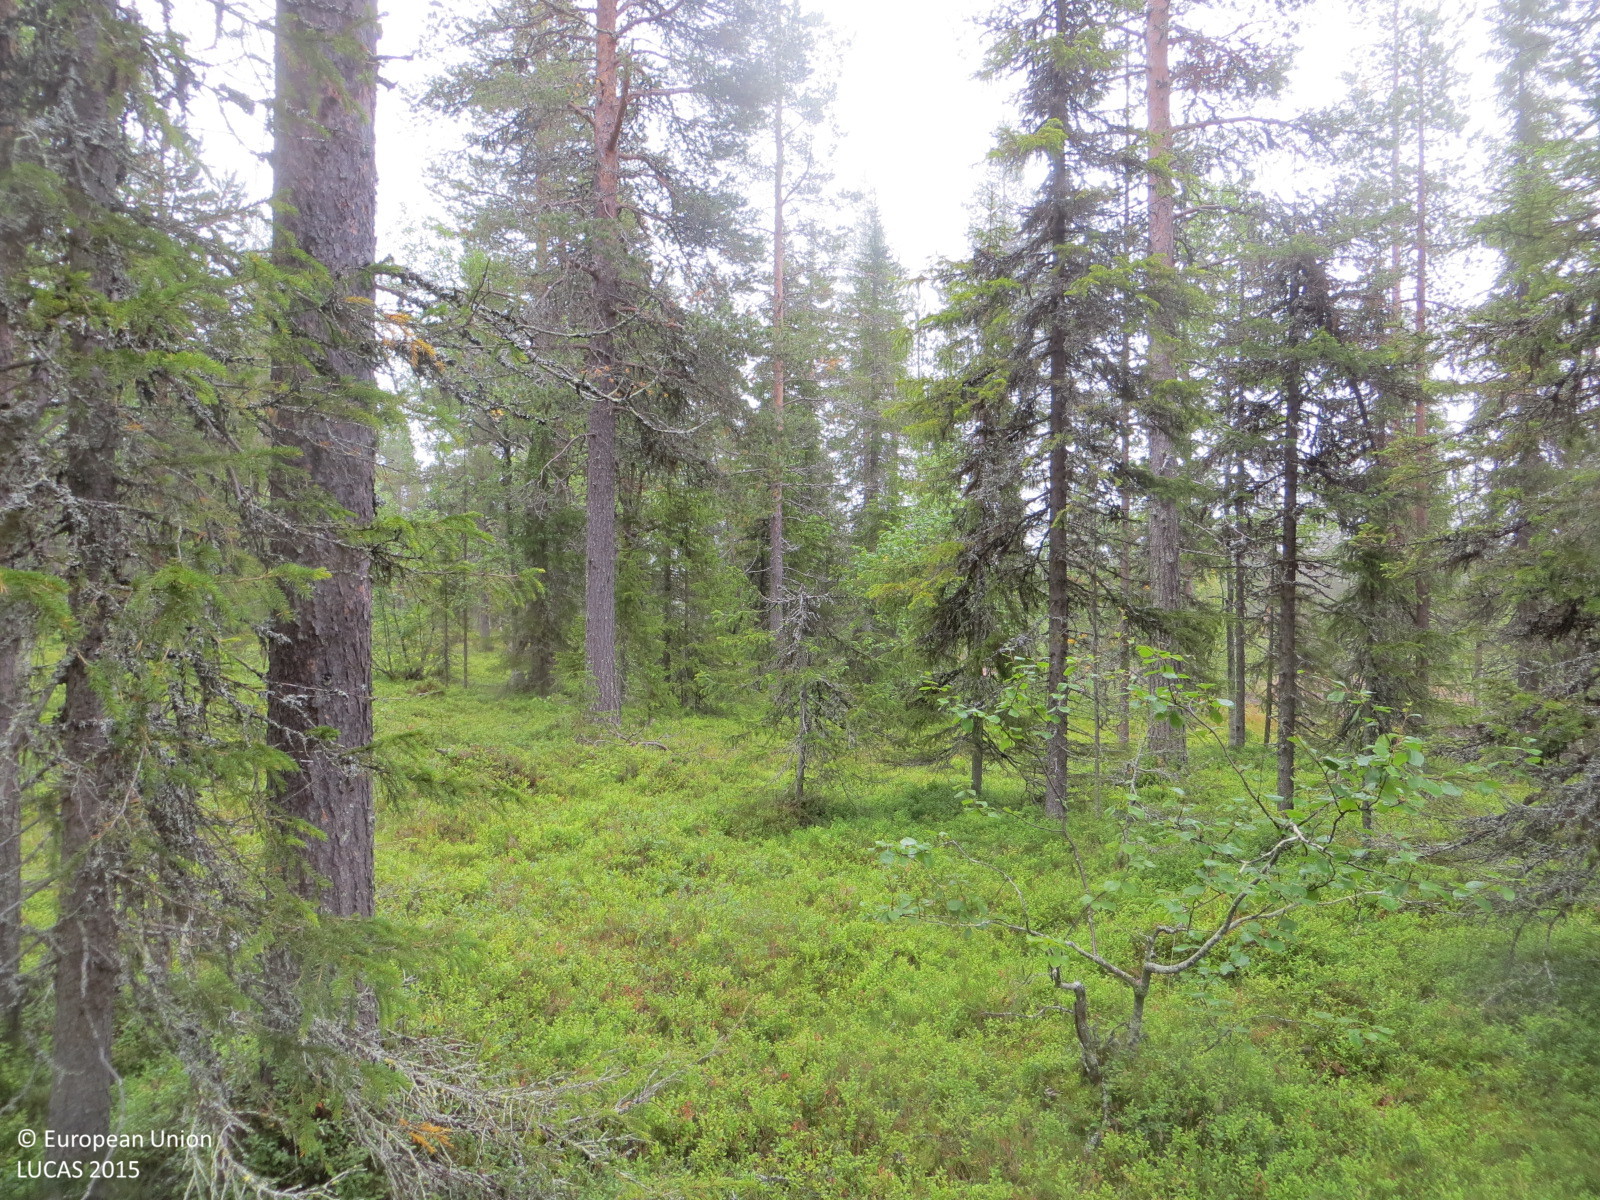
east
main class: Woodland
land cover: Pine dominated coniferous woodland
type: boreal forest
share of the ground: 50 - 75 %
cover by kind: coniferous forest trees 50 %, shrubs 40 %, broadleaved forest trees 10 %
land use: Forestry
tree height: > 5 m
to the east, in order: Pine dominated coniferous woodland; Shrubland with sparse tree cover; Pine dominated coniferous woodland; Rocks and stones; Pine dominated coniferous woodland
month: August
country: FI
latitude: 67.6363
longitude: 24.8007
